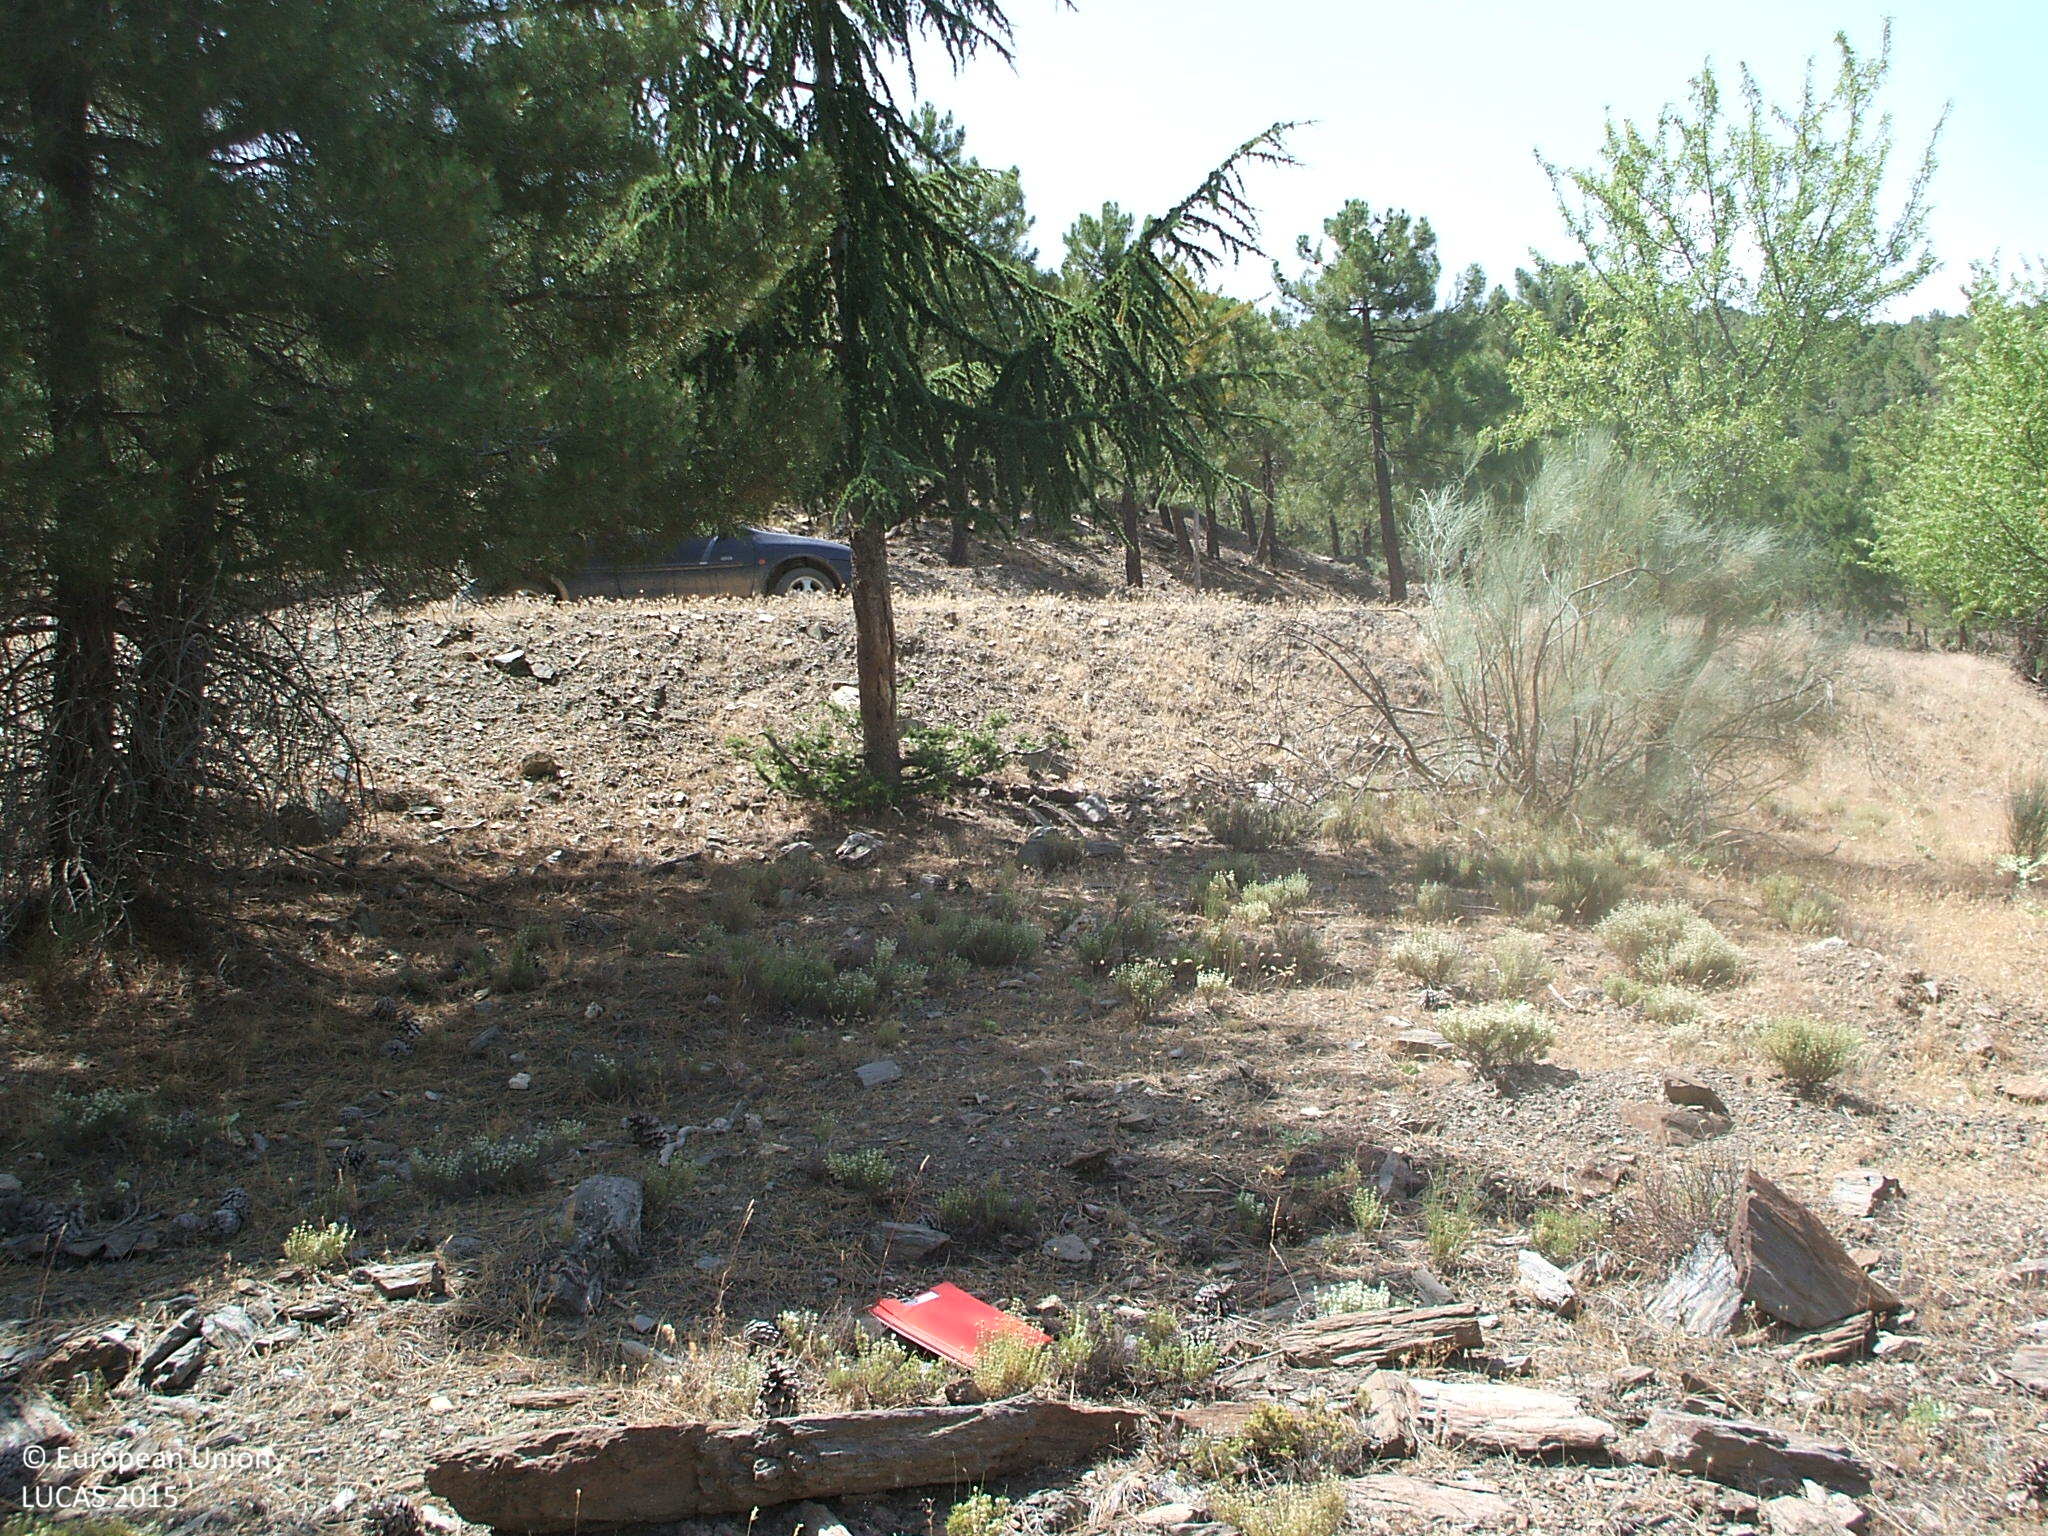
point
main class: Woodland
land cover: Pine dominated coniferous woodland
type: coniferous forest of the mediterranean region
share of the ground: 10 - 25 %
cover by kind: herbaceous plants 40 %, shrubs 30 %, coniferous forest trees 15 %, consolidated bare surface 15 %
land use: Semi-natural and natural areas not in use
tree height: > 5 m
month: July
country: ES
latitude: 37.2663
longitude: -2.6462
